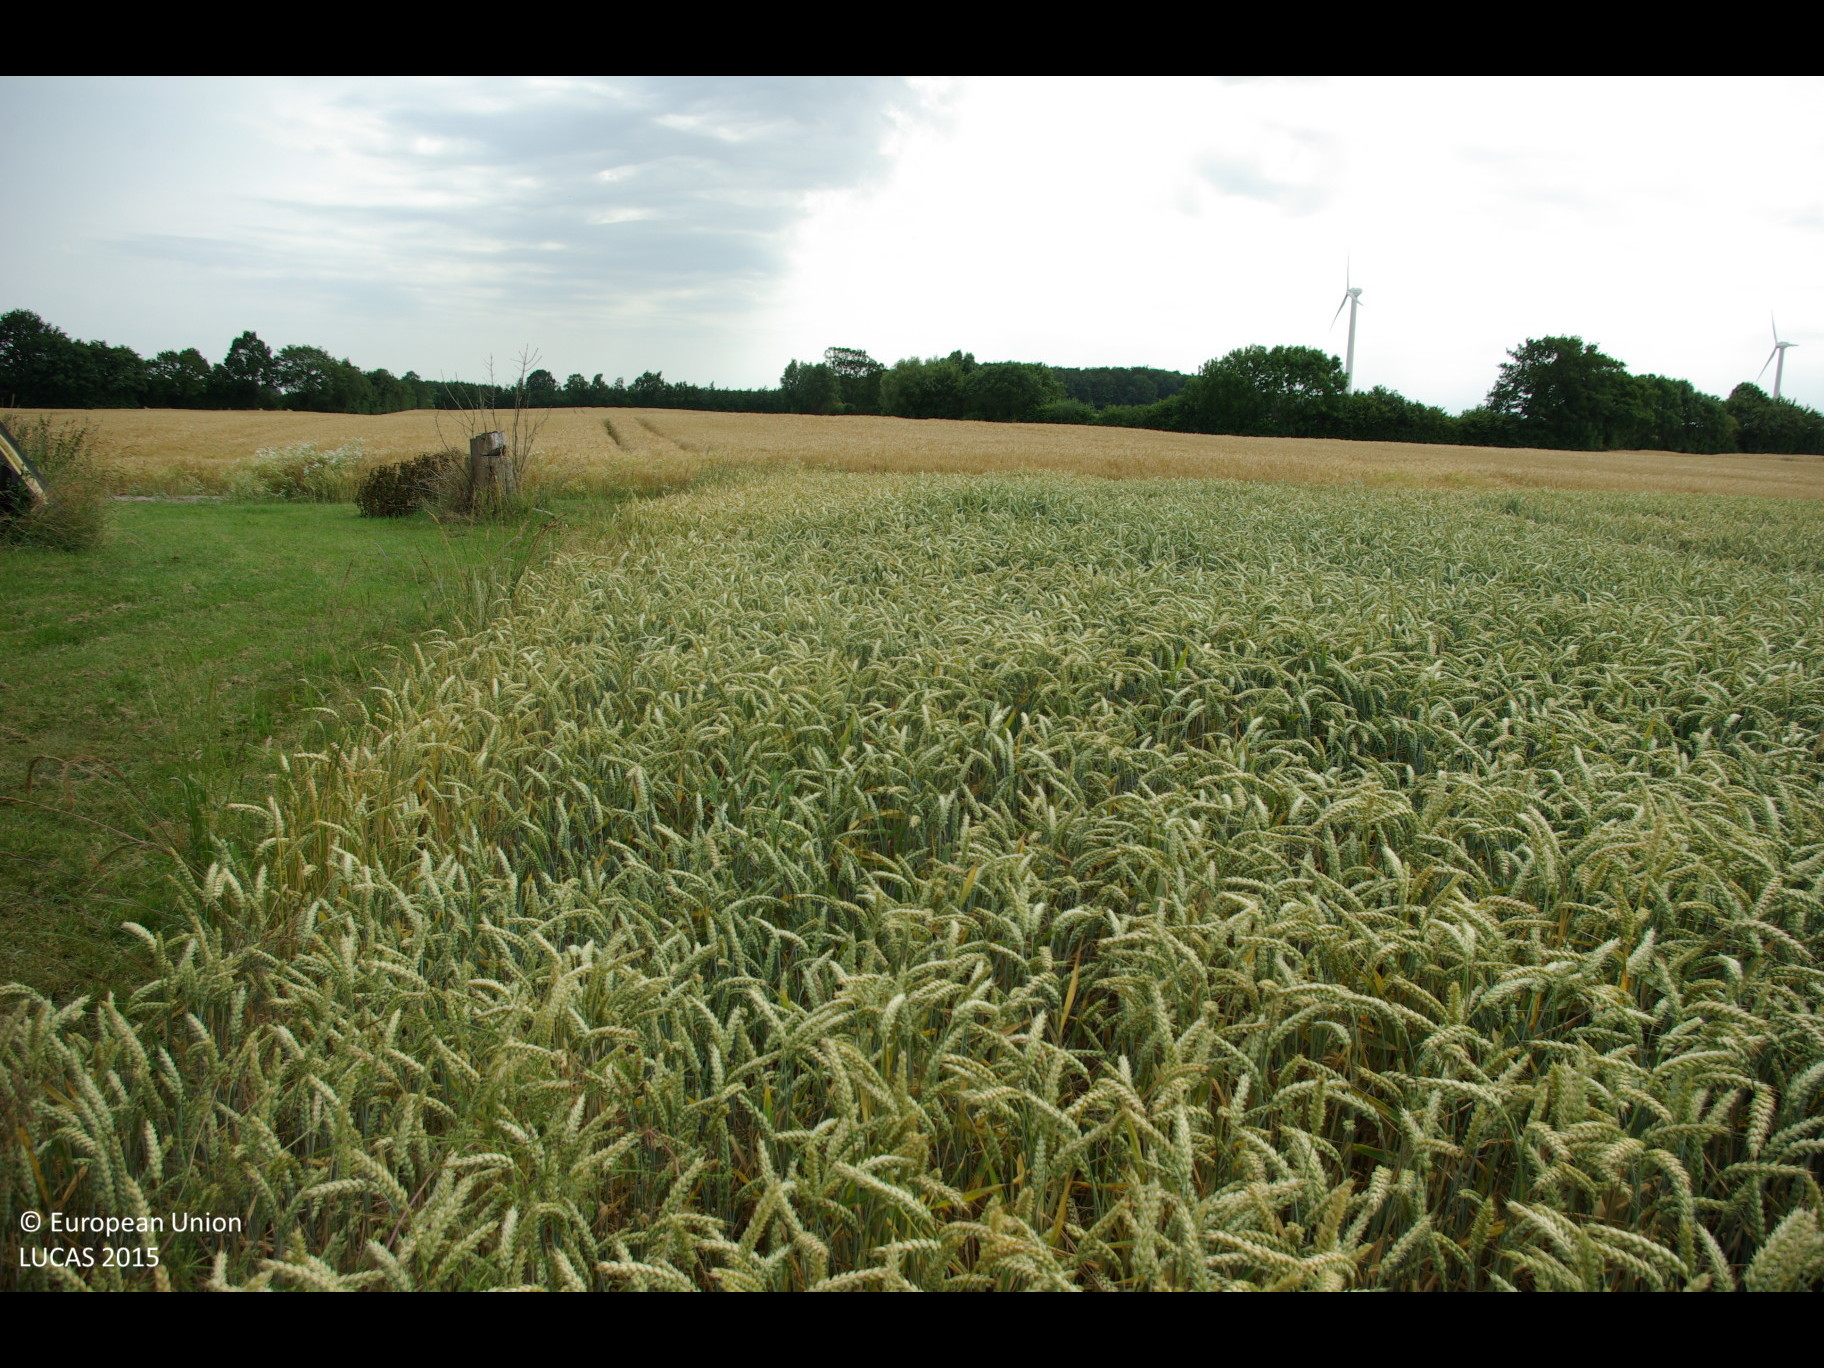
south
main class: Cropland
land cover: Common wheat
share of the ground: > 75 %
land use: Agriculture (excluding fallow land and kitchen gardens)
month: July
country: DE
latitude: 54.7139
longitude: 9.9224
